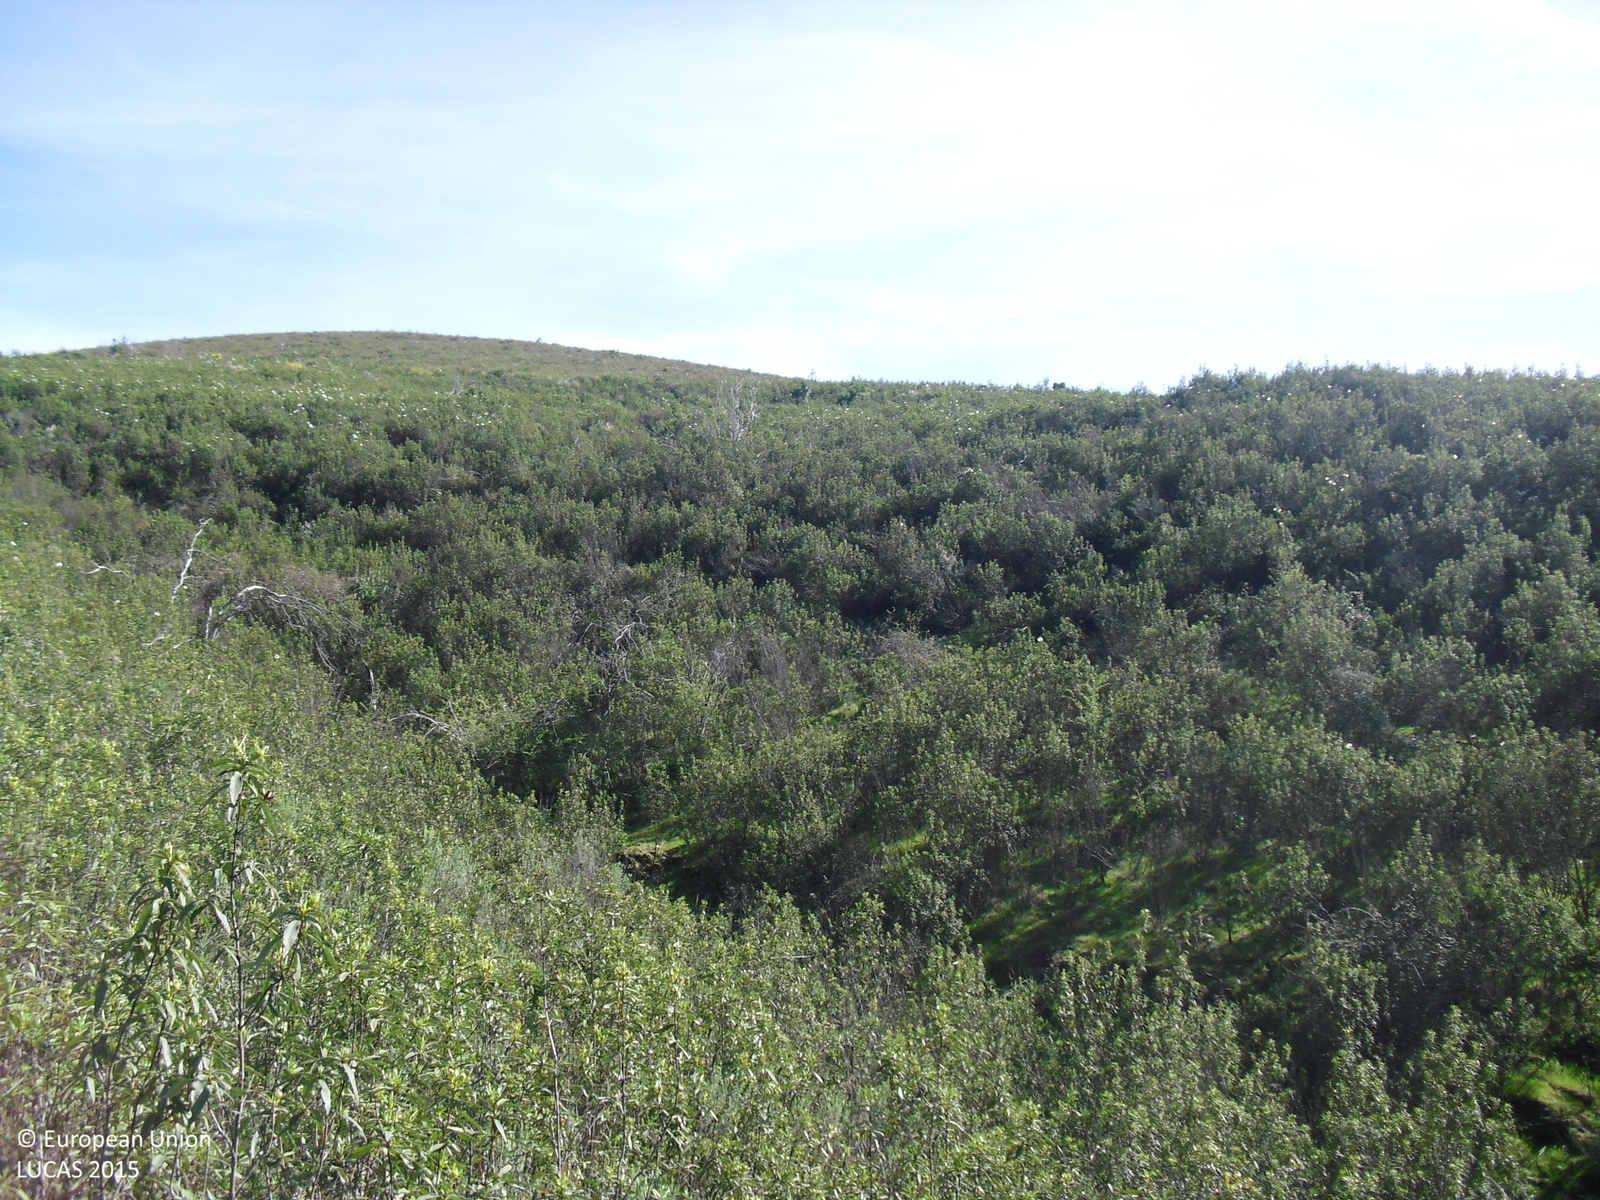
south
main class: Shrubland
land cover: Shrubland without tree cover
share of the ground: > 75 %
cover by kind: shrubs 100 %
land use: Semi-natural and natural areas not in use
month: April
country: ES
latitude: 39.3878
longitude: -5.3145
